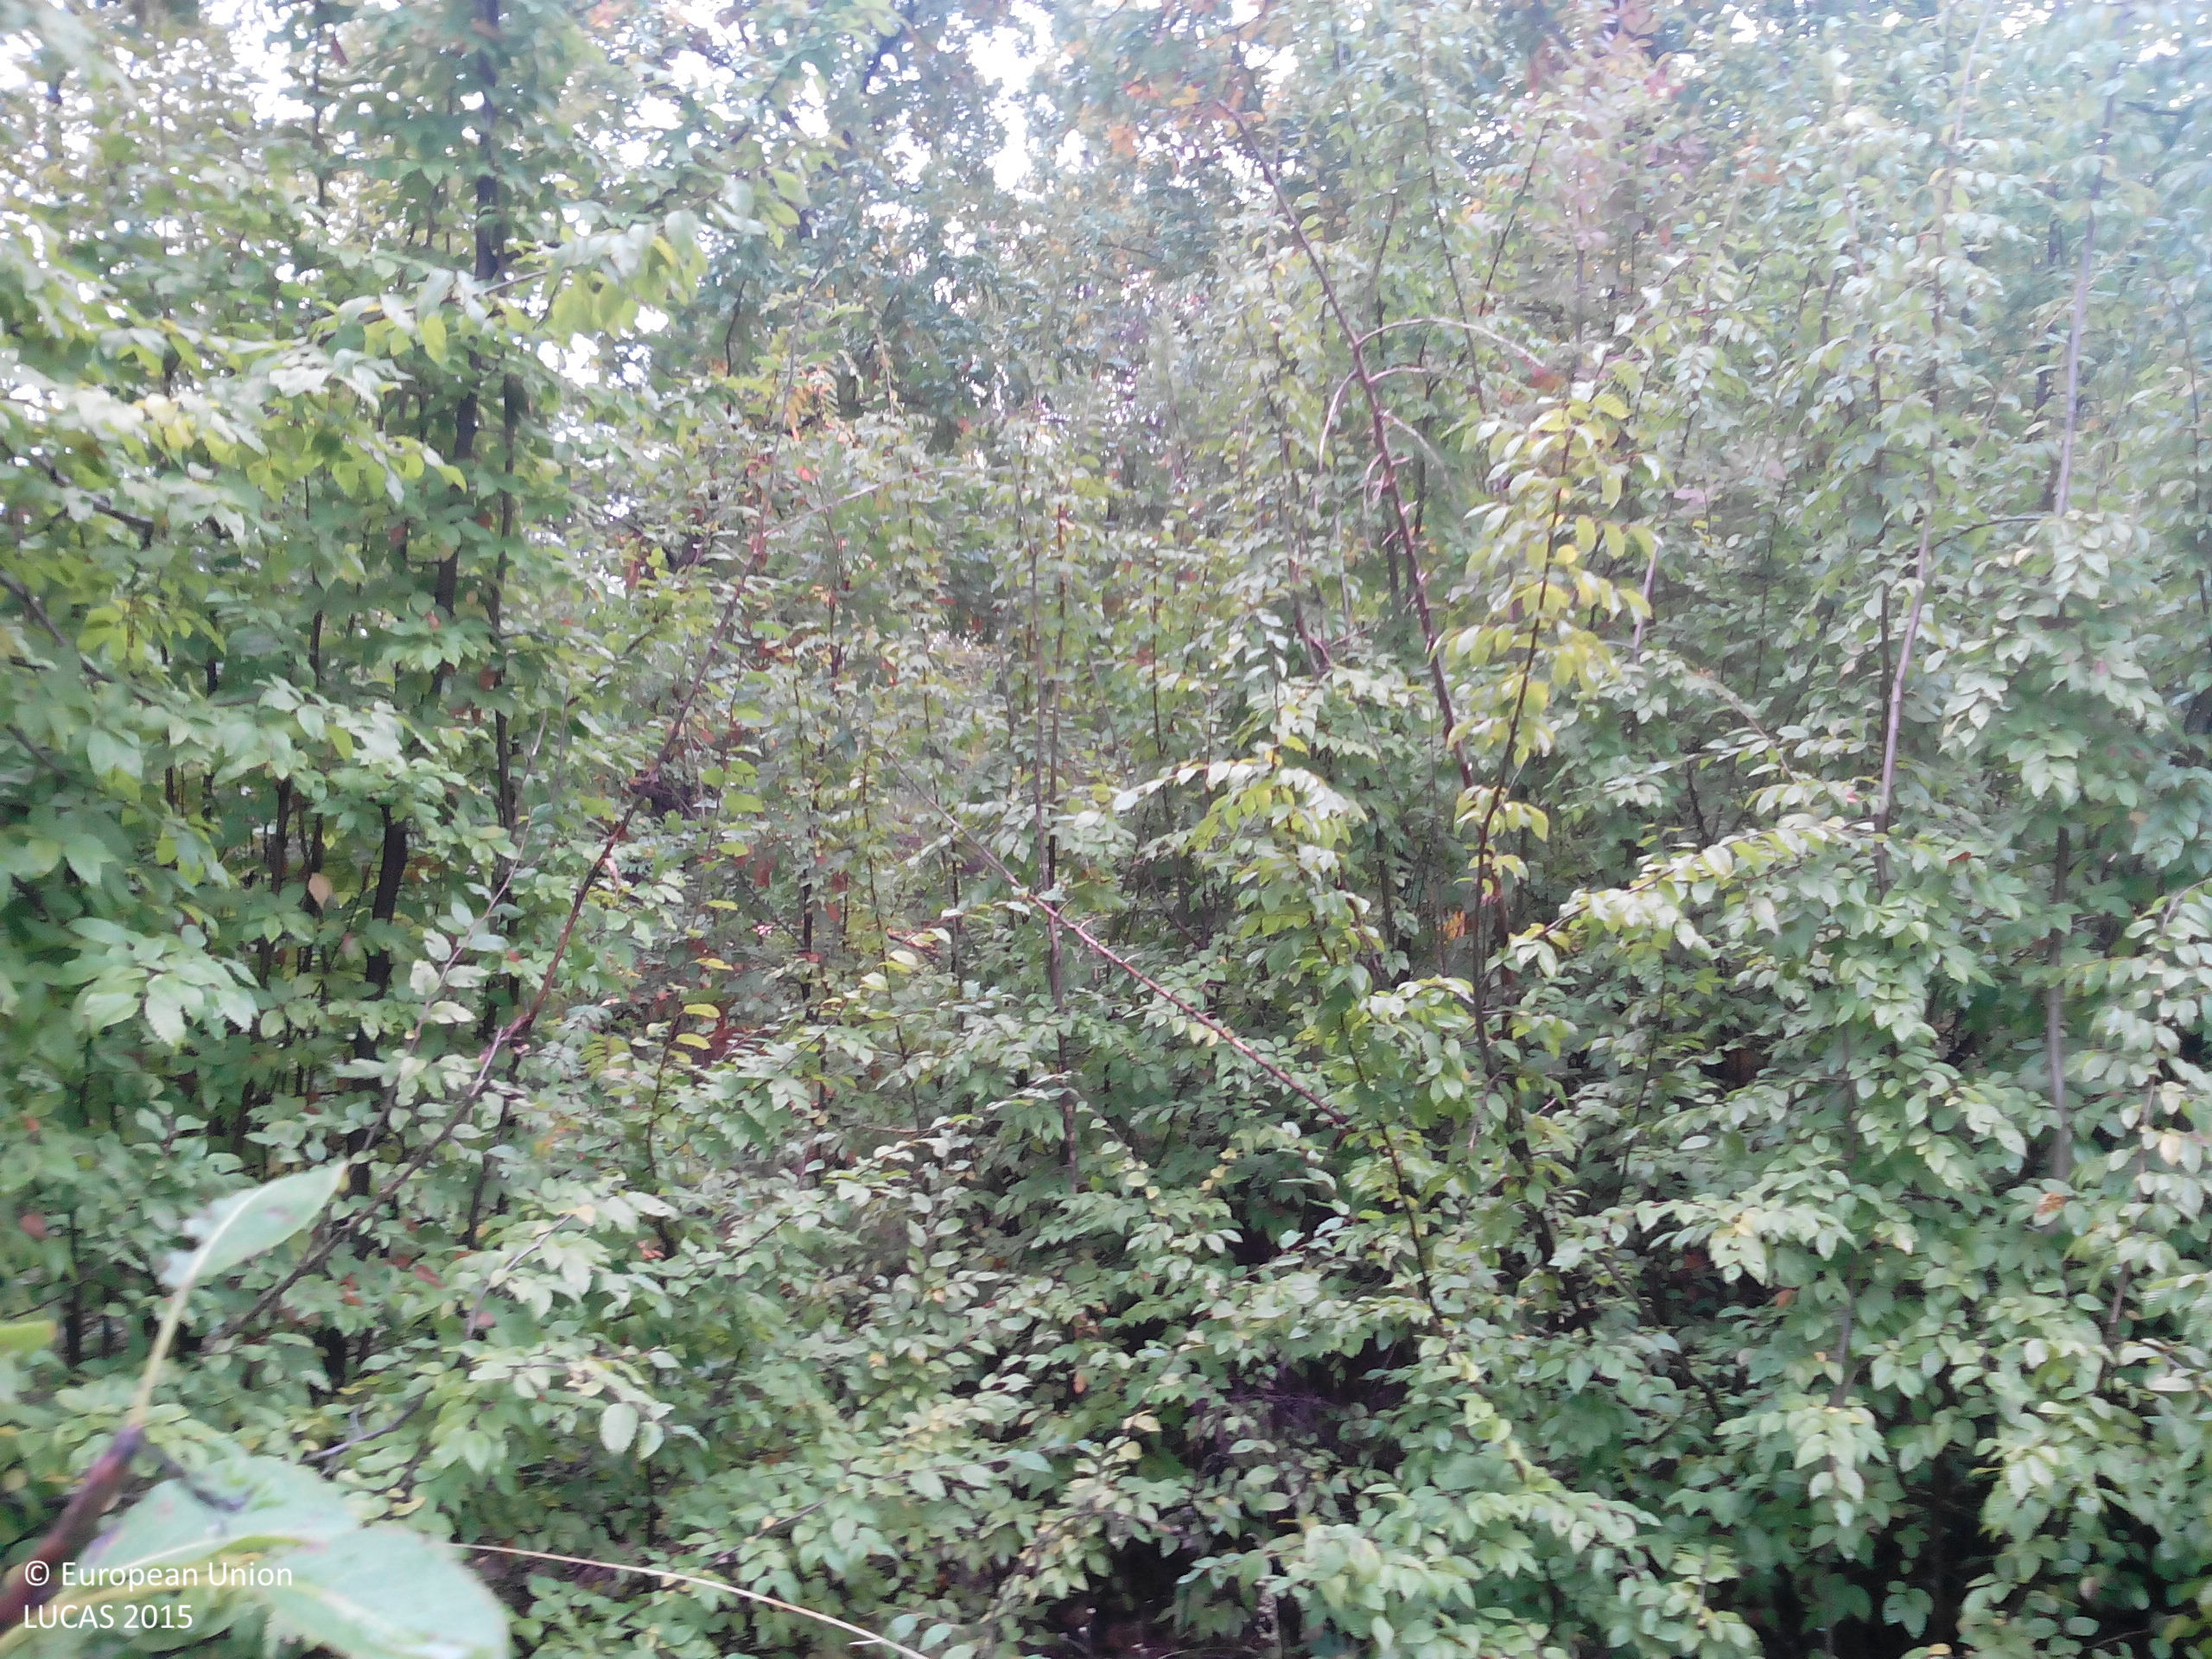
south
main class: Woodland
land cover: Broadleaved woodland
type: acidophilous oak and oak-birch forest
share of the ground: > 75 %
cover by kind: broadleaved forest trees 90 %, shrubs 5 %, herbaceous plants 5 %
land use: Forestry
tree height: > 5 m
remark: Clear cut
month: October
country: BG
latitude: 43.1151
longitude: 24.0478
